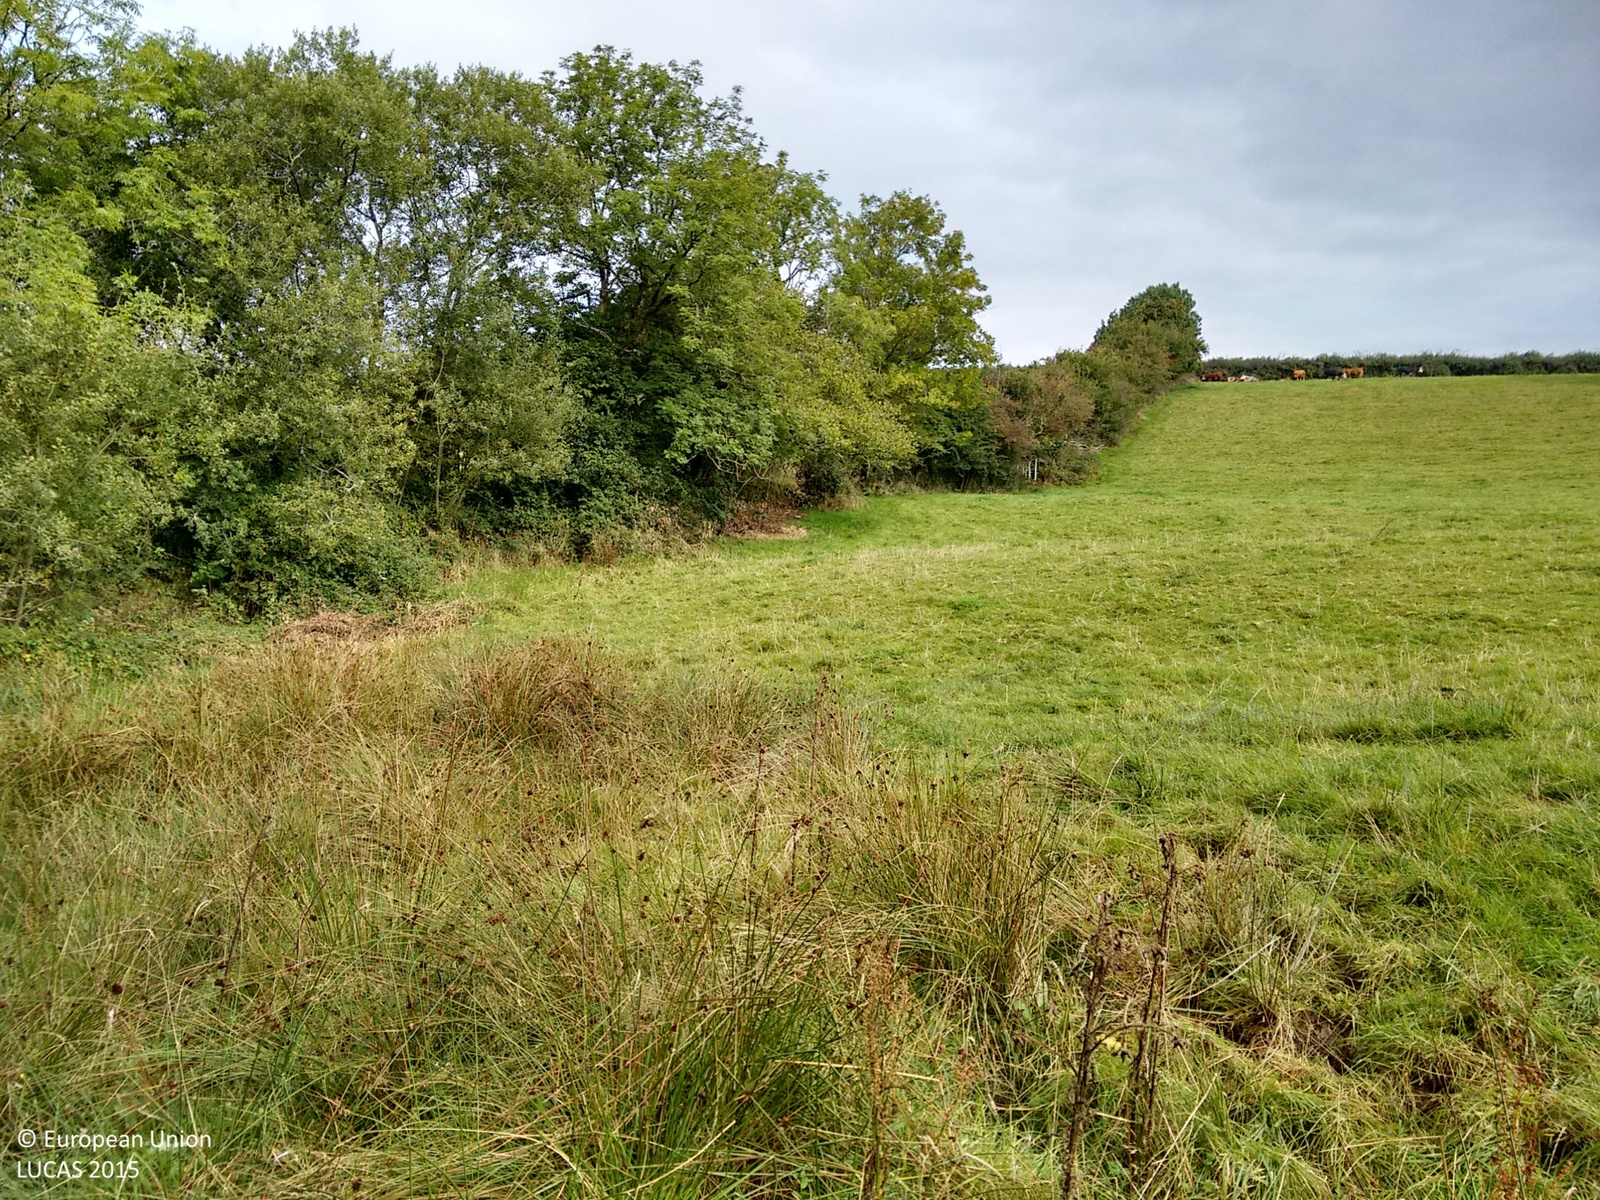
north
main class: Woodland
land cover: Broadleaved woodland
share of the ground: > 75 %
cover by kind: broadleaved forest trees 90 %, herbaceous plants 10 %
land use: Agriculture (excluding fallow land and kitchen gardens)
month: September
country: GB
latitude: 52.0653
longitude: -4.5030
